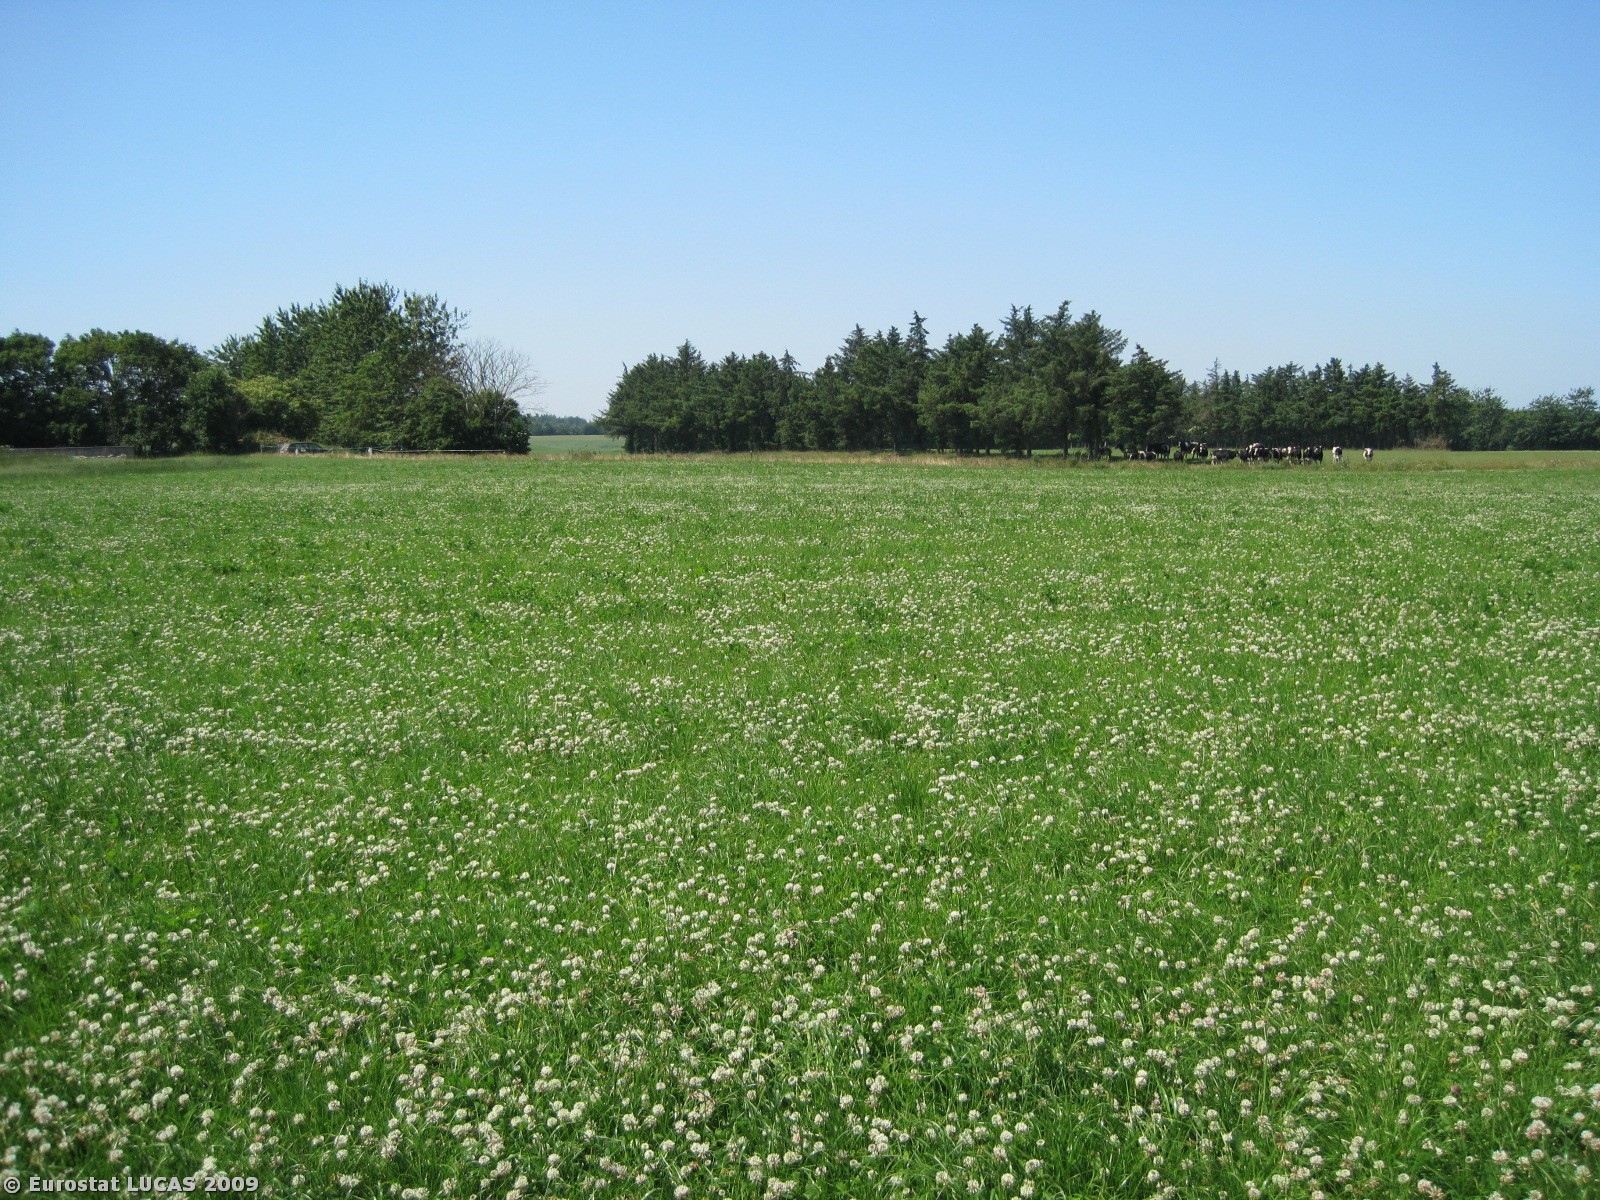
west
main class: Grassland
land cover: Grassland without tree/shrub cover
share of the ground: > 75 %
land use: Agriculture (excluding fallow land and kitchen gardens)
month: July
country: DK
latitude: 56.4637
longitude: 8.2655
